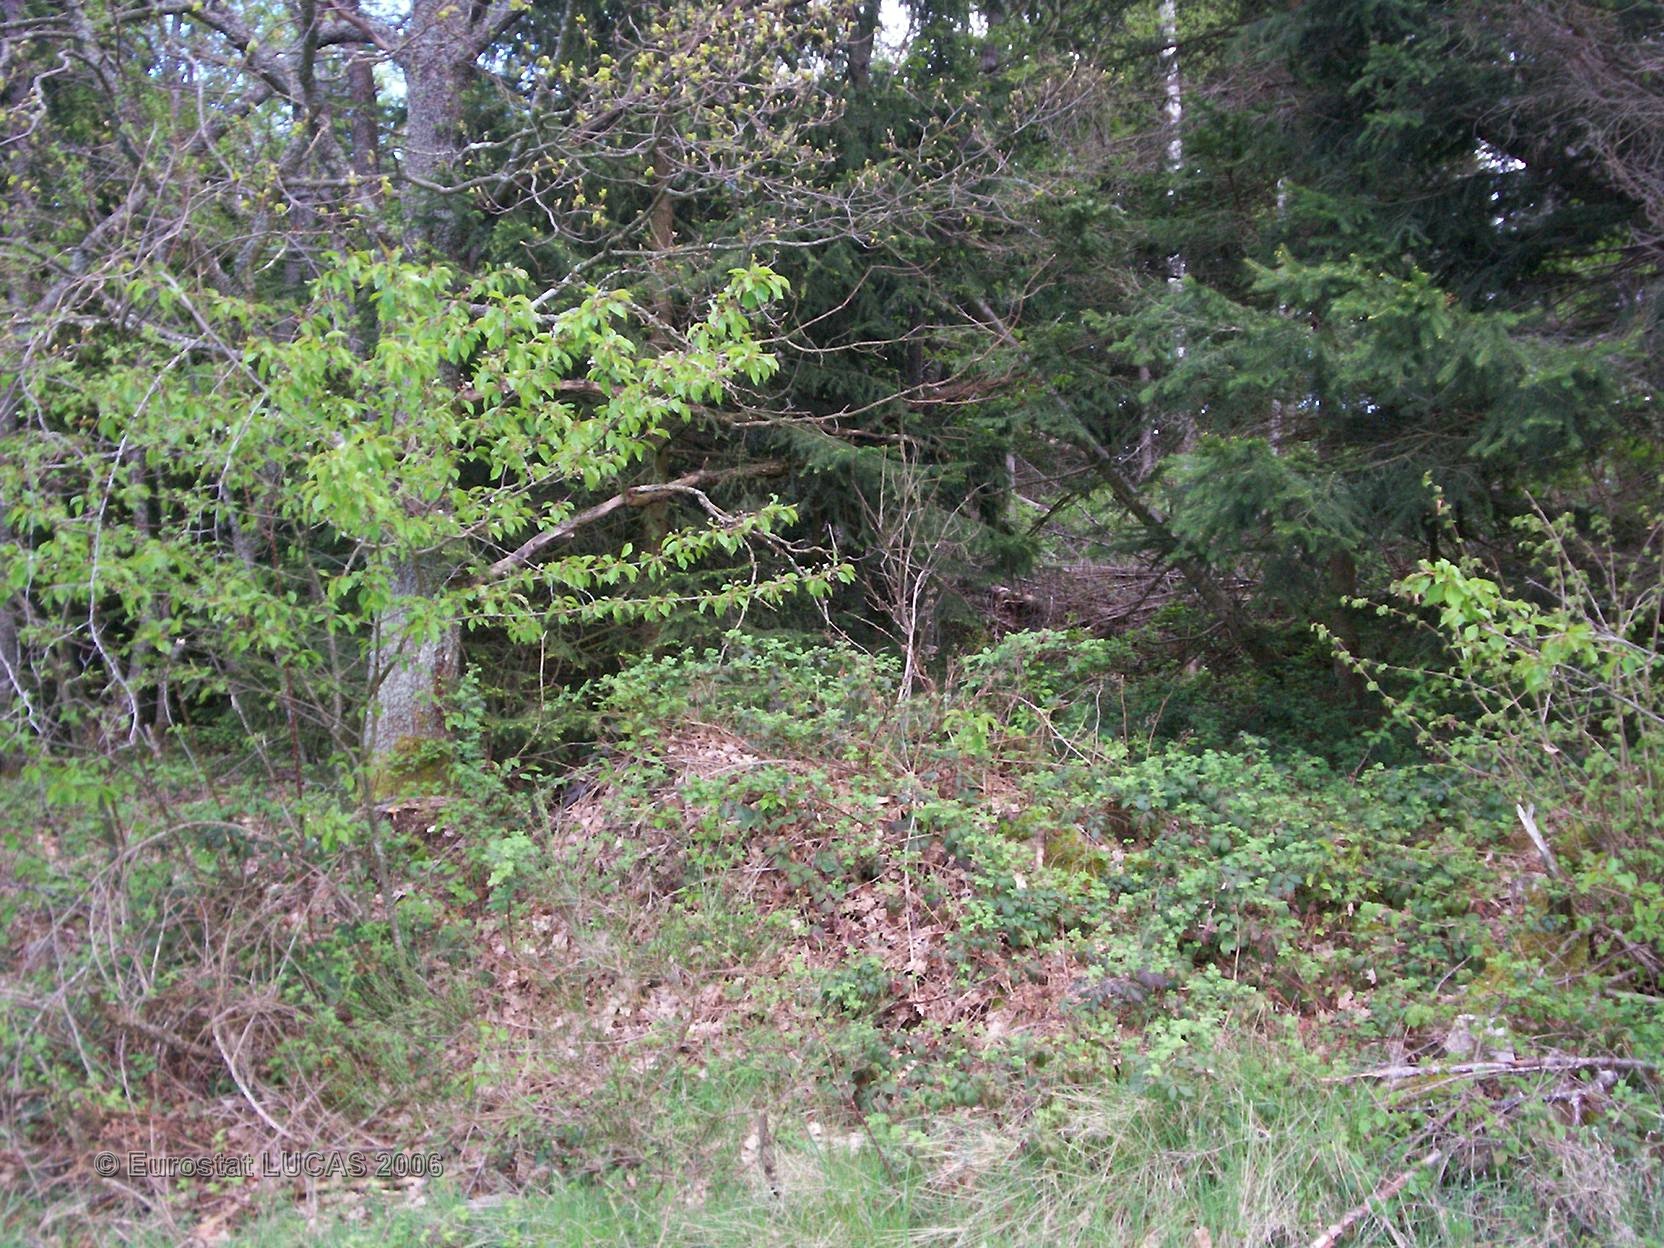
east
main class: Grassland
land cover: Grassland without tree/shrub cover
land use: Agriculture (excluding fallow land and kitchen gardens)
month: May
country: FR
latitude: 45.1664
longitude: 3.3230
